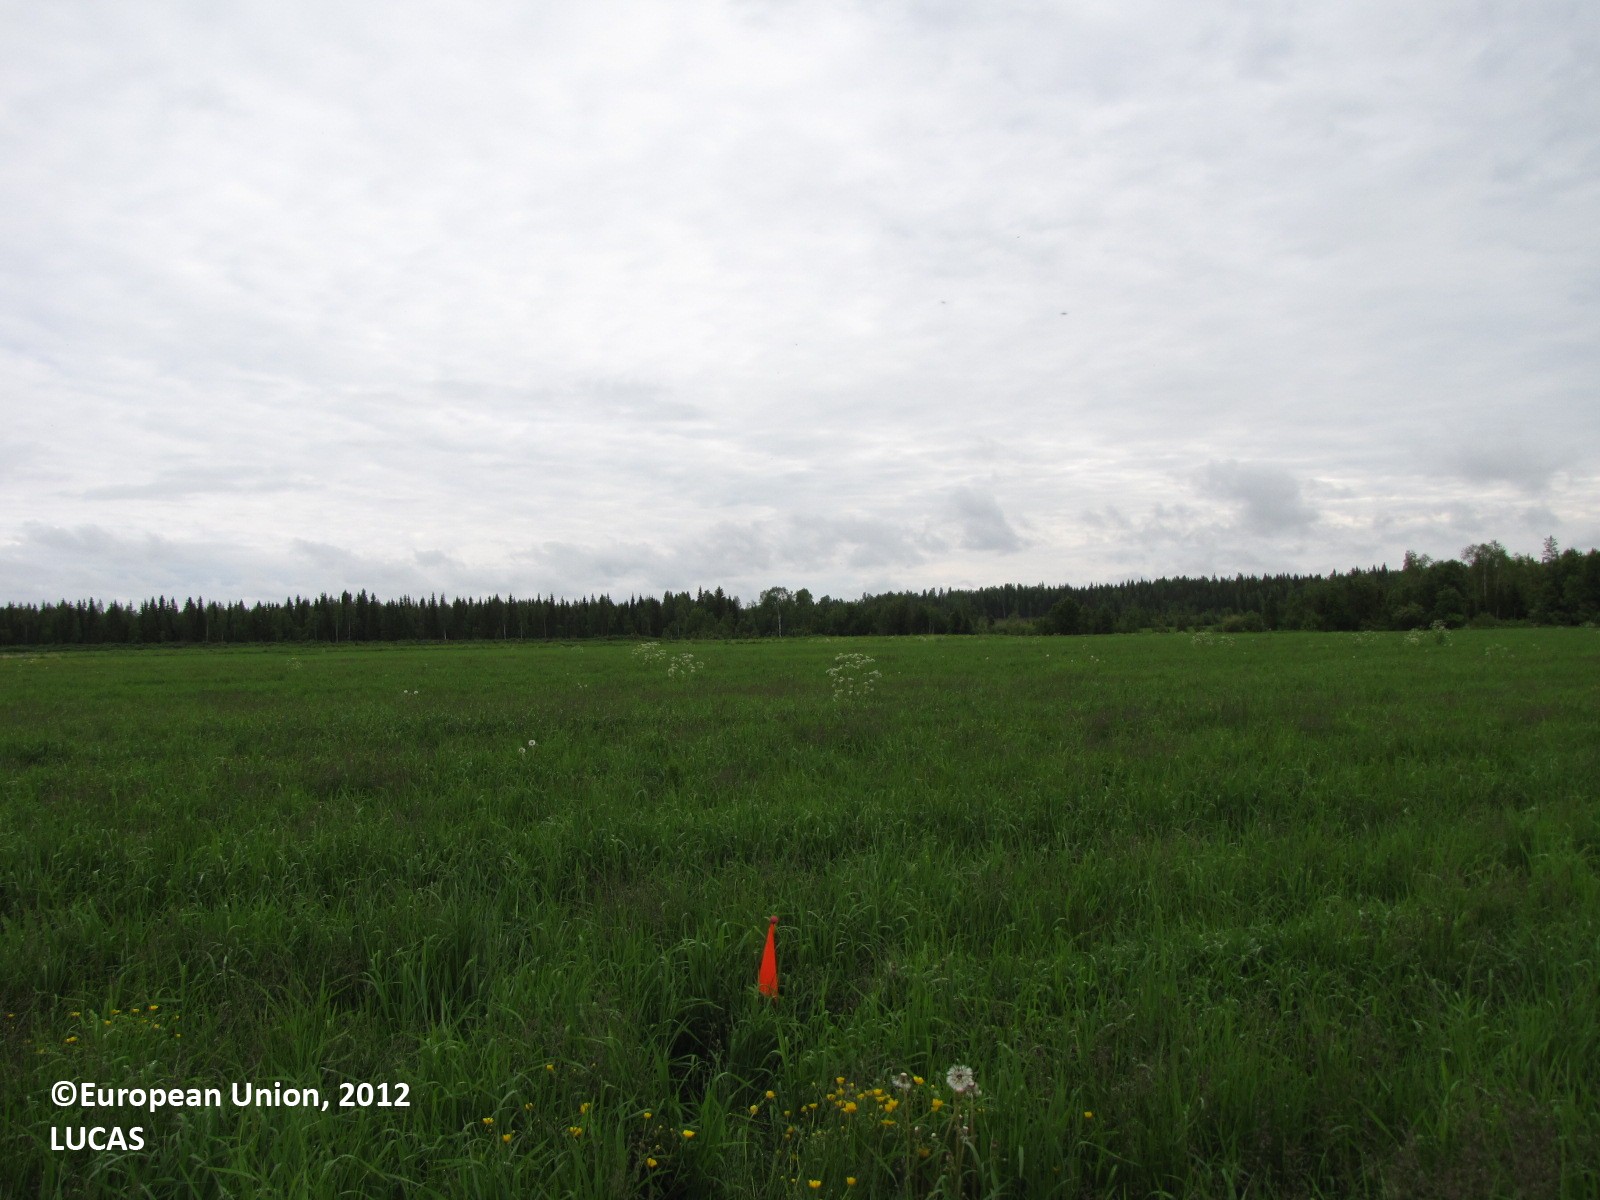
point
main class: Grassland
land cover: Grassland without tree/shrub cover
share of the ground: > 75 %
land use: Agriculture (excluding fallow land and kitchen gardens)
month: June
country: FI
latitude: 66.1630
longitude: 24.7104
